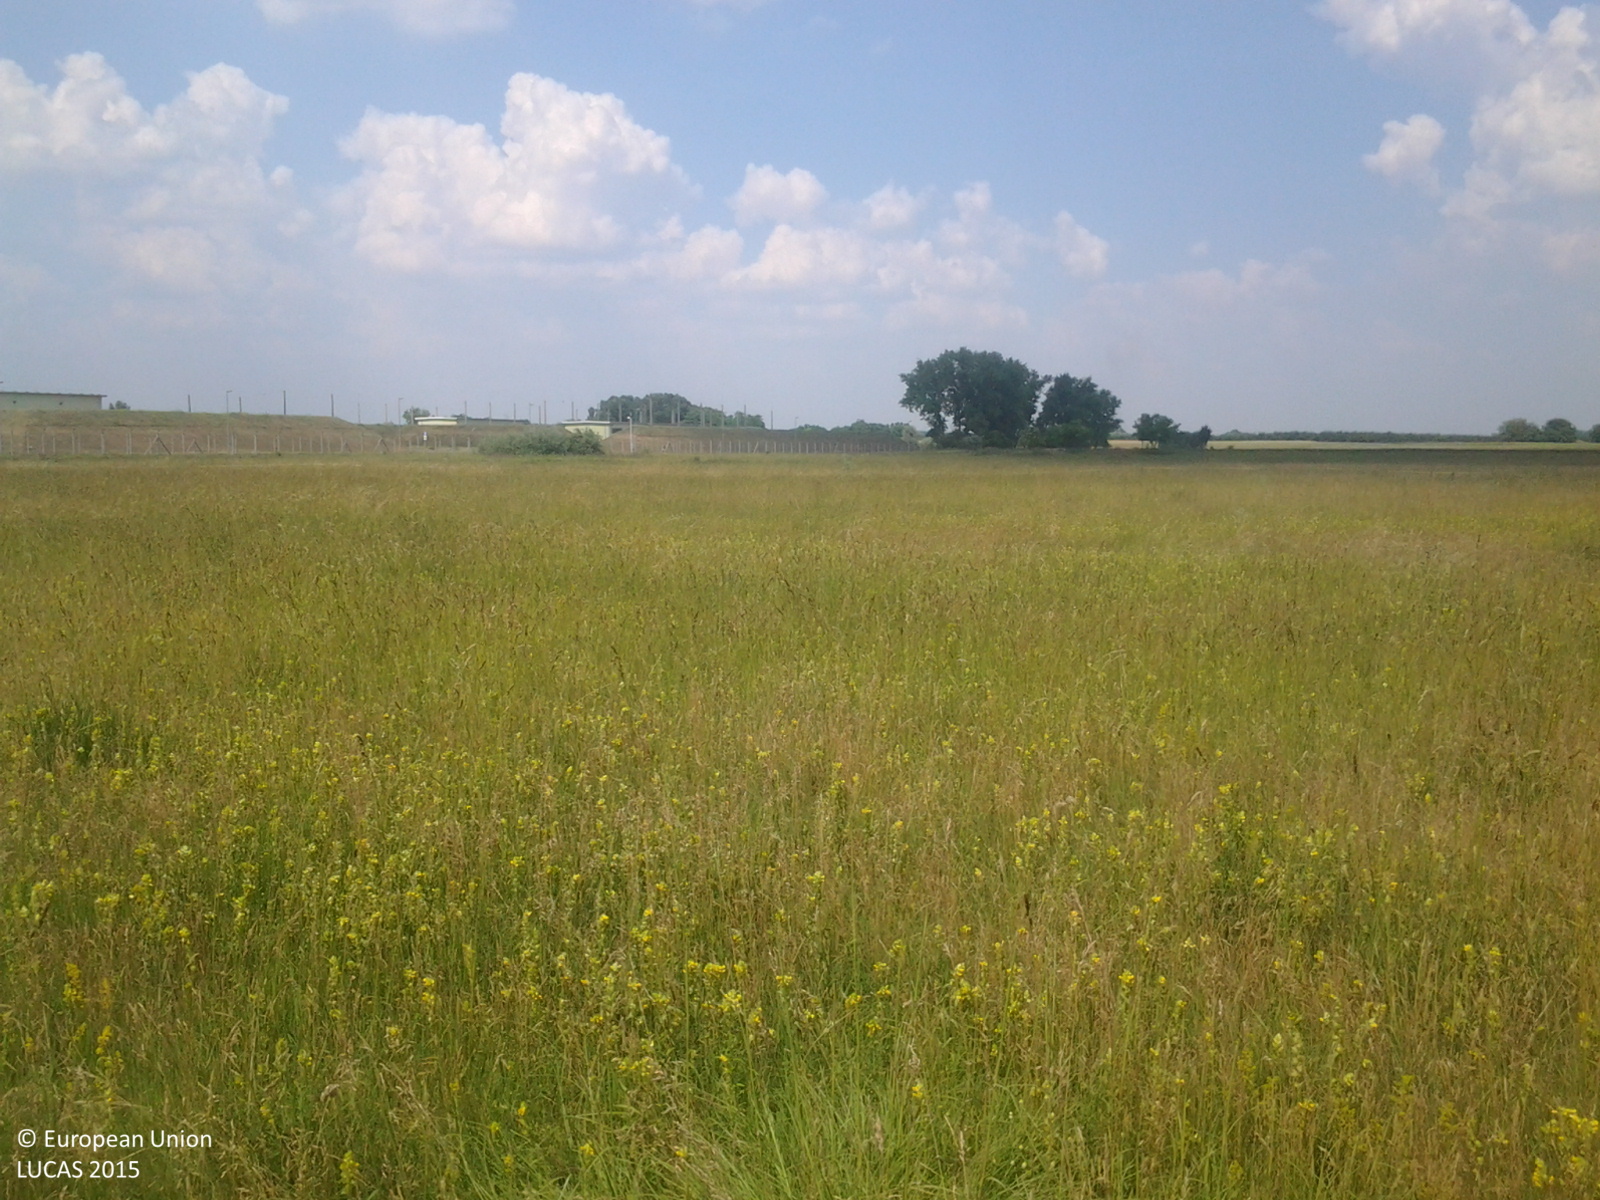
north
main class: Grassland
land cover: Grassland without tree/shrub cover
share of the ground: > 75 %
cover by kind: herbaceous plants 100 %
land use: Agriculture (excluding fallow land and kitchen gardens)
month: June
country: HU
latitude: 46.9177
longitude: 19.7779
